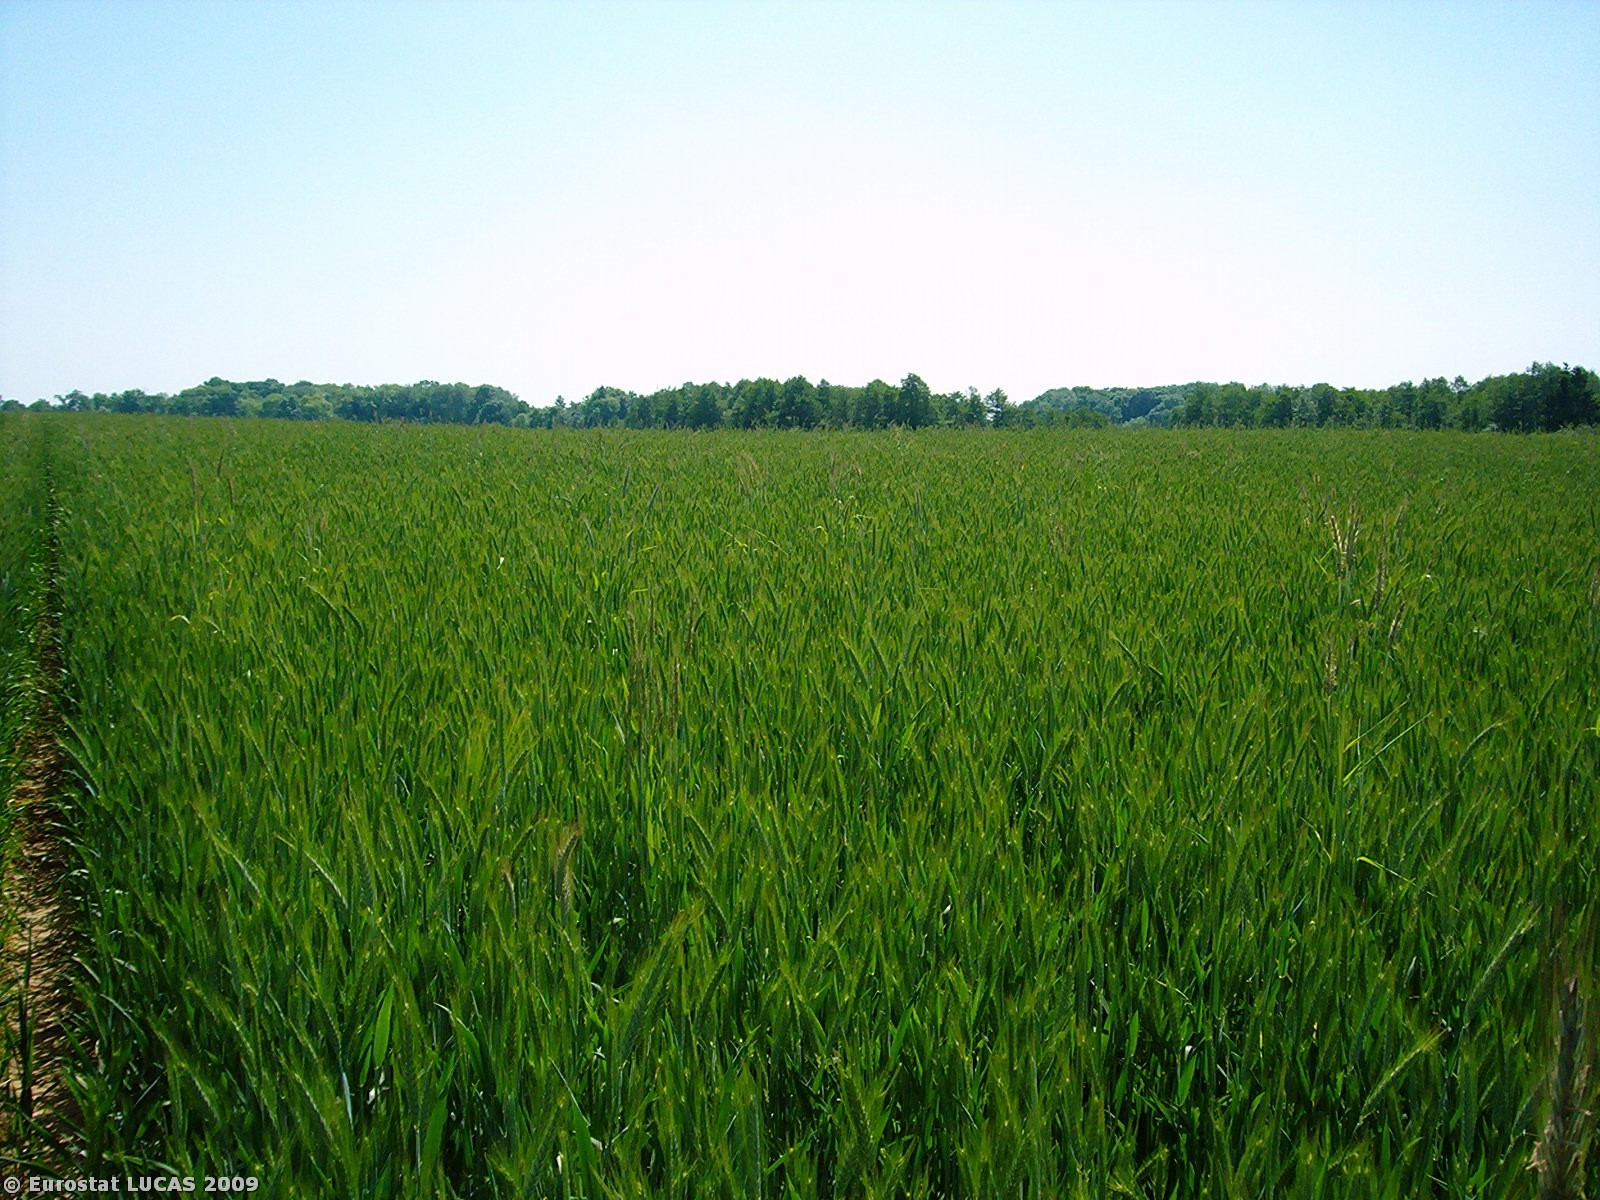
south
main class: Cropland
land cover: Rye
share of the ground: > 75 %
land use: Agriculture (excluding fallow land and kitchen gardens)
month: May
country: PL
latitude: 52.5299
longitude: 16.3898
